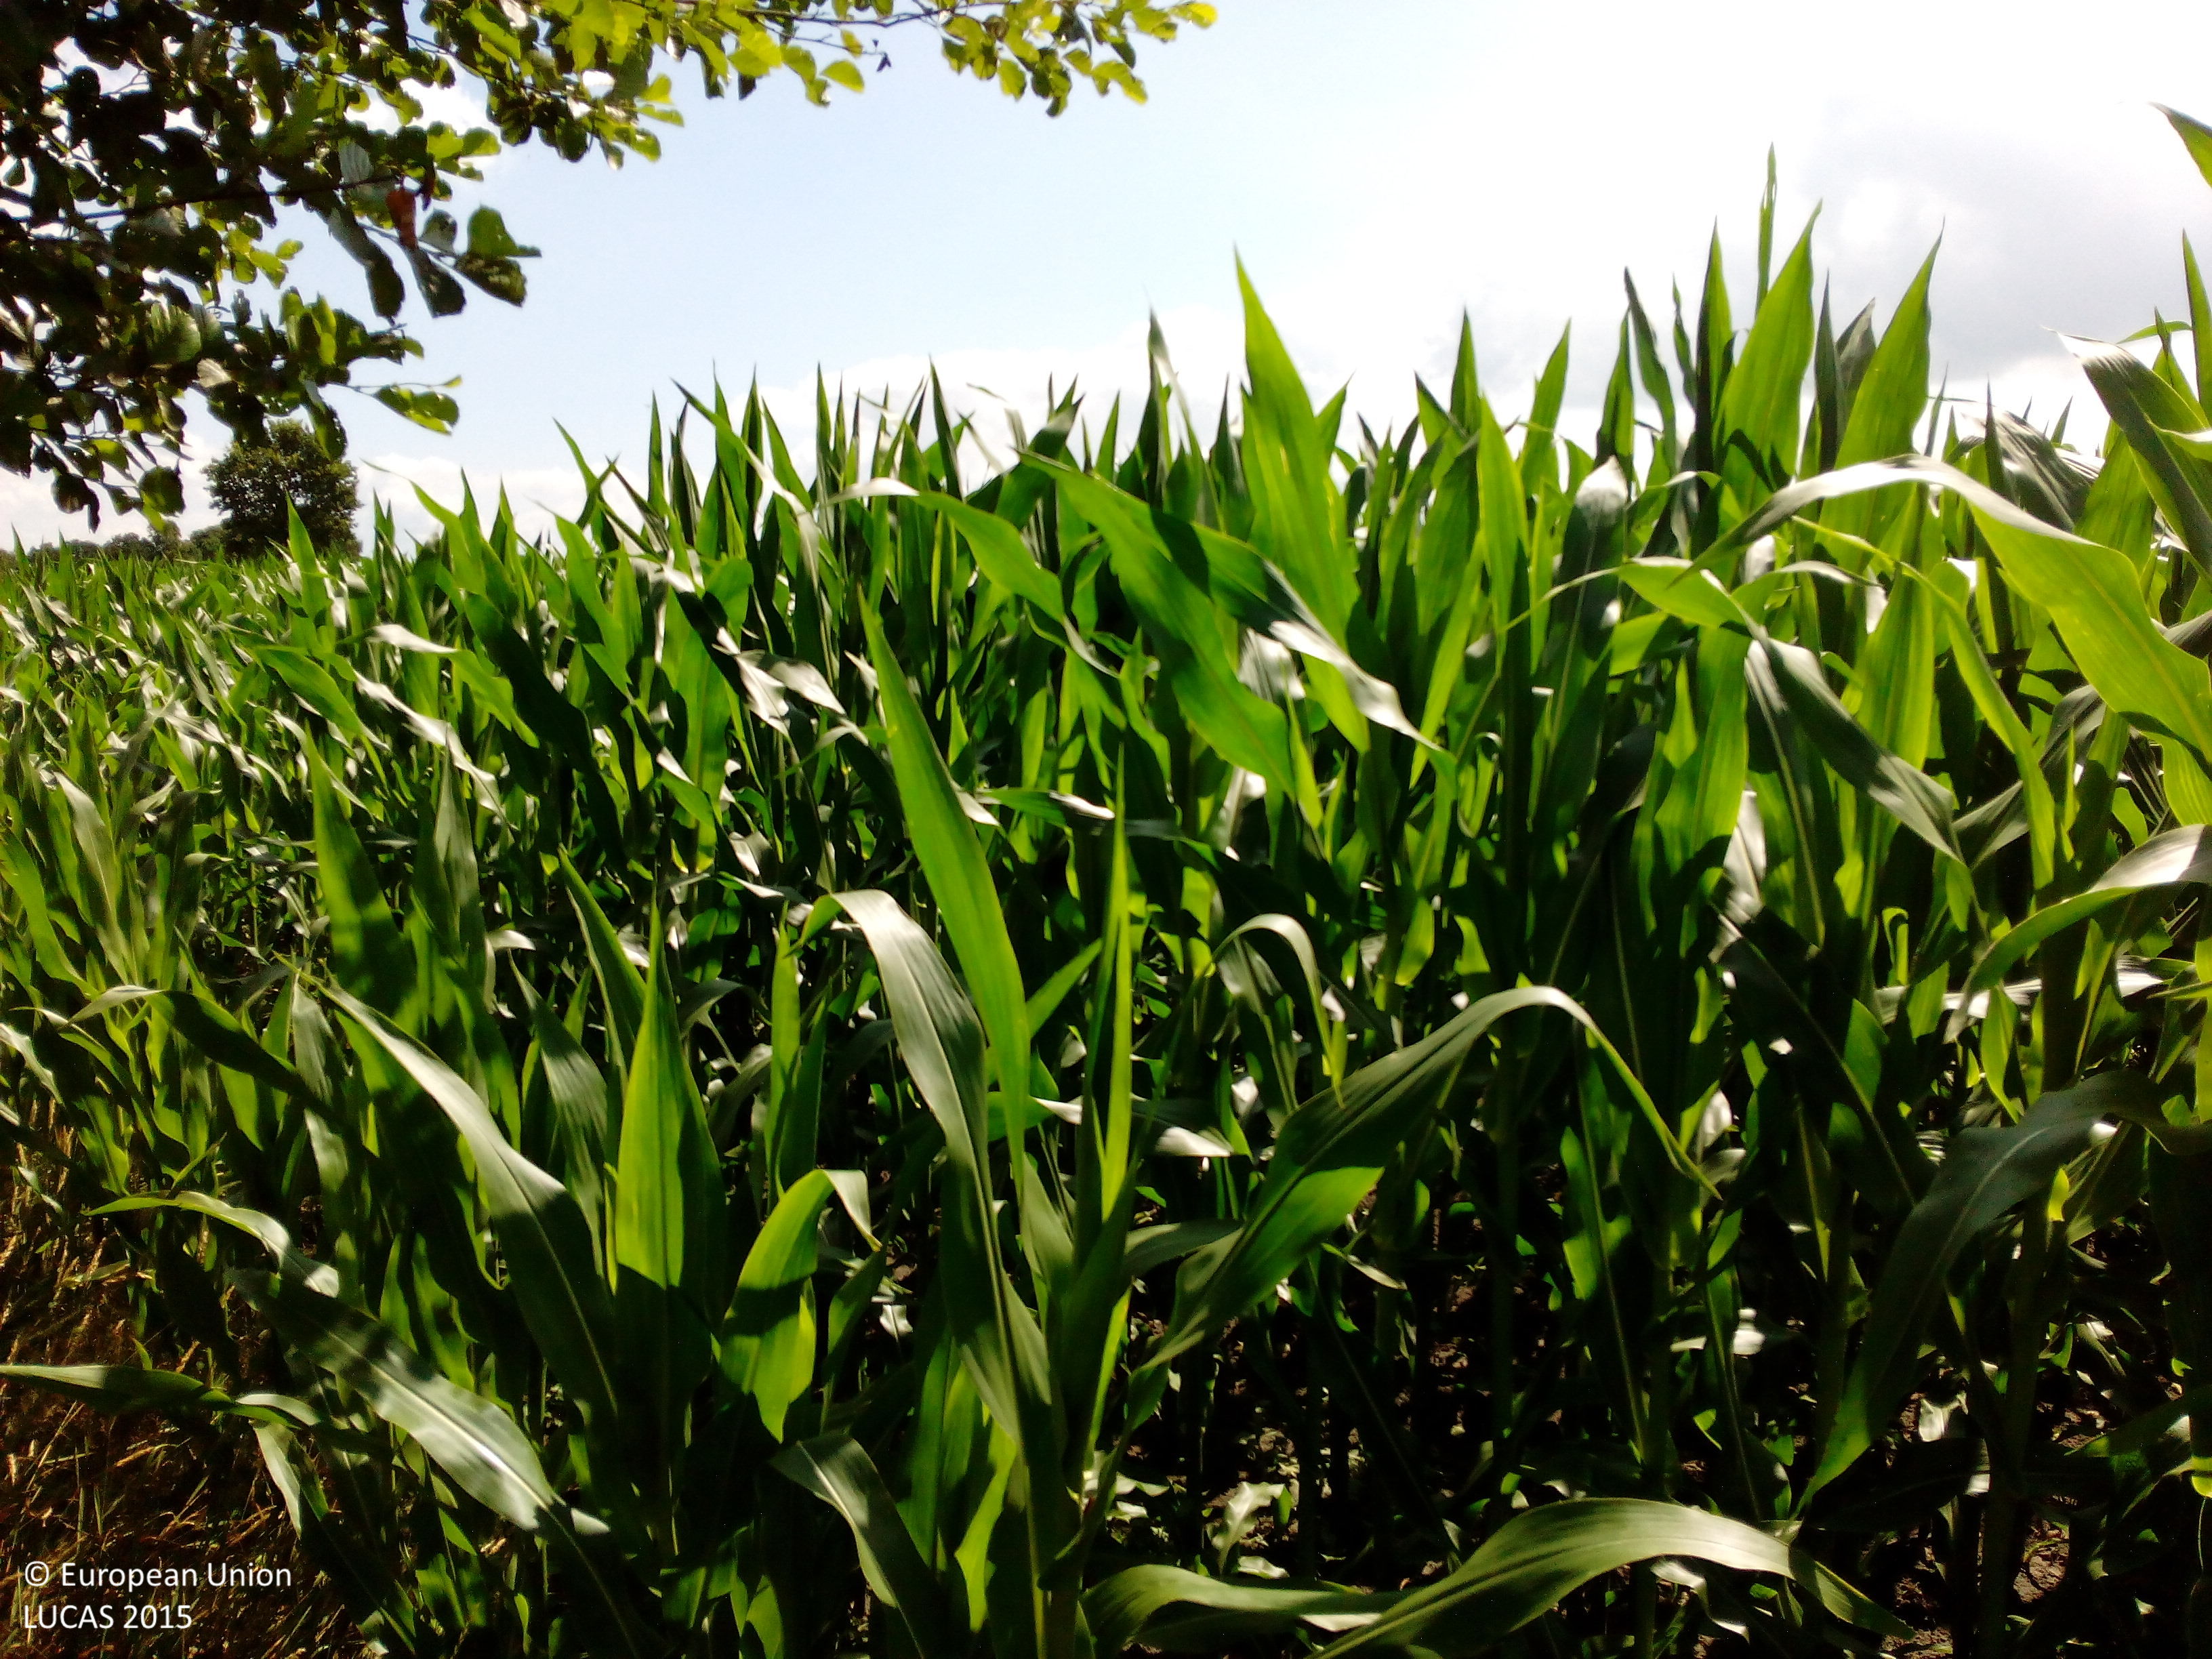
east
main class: Cropland
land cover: Maize
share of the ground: > 75 %
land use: Agriculture (excluding fallow land and kitchen gardens)
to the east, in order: Maize; Lines of trees; Maize; Grass margins; Ditches and canals; Grass margins; Tracks; Nurseries
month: July
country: DE
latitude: 53.1324
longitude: 7.9231
